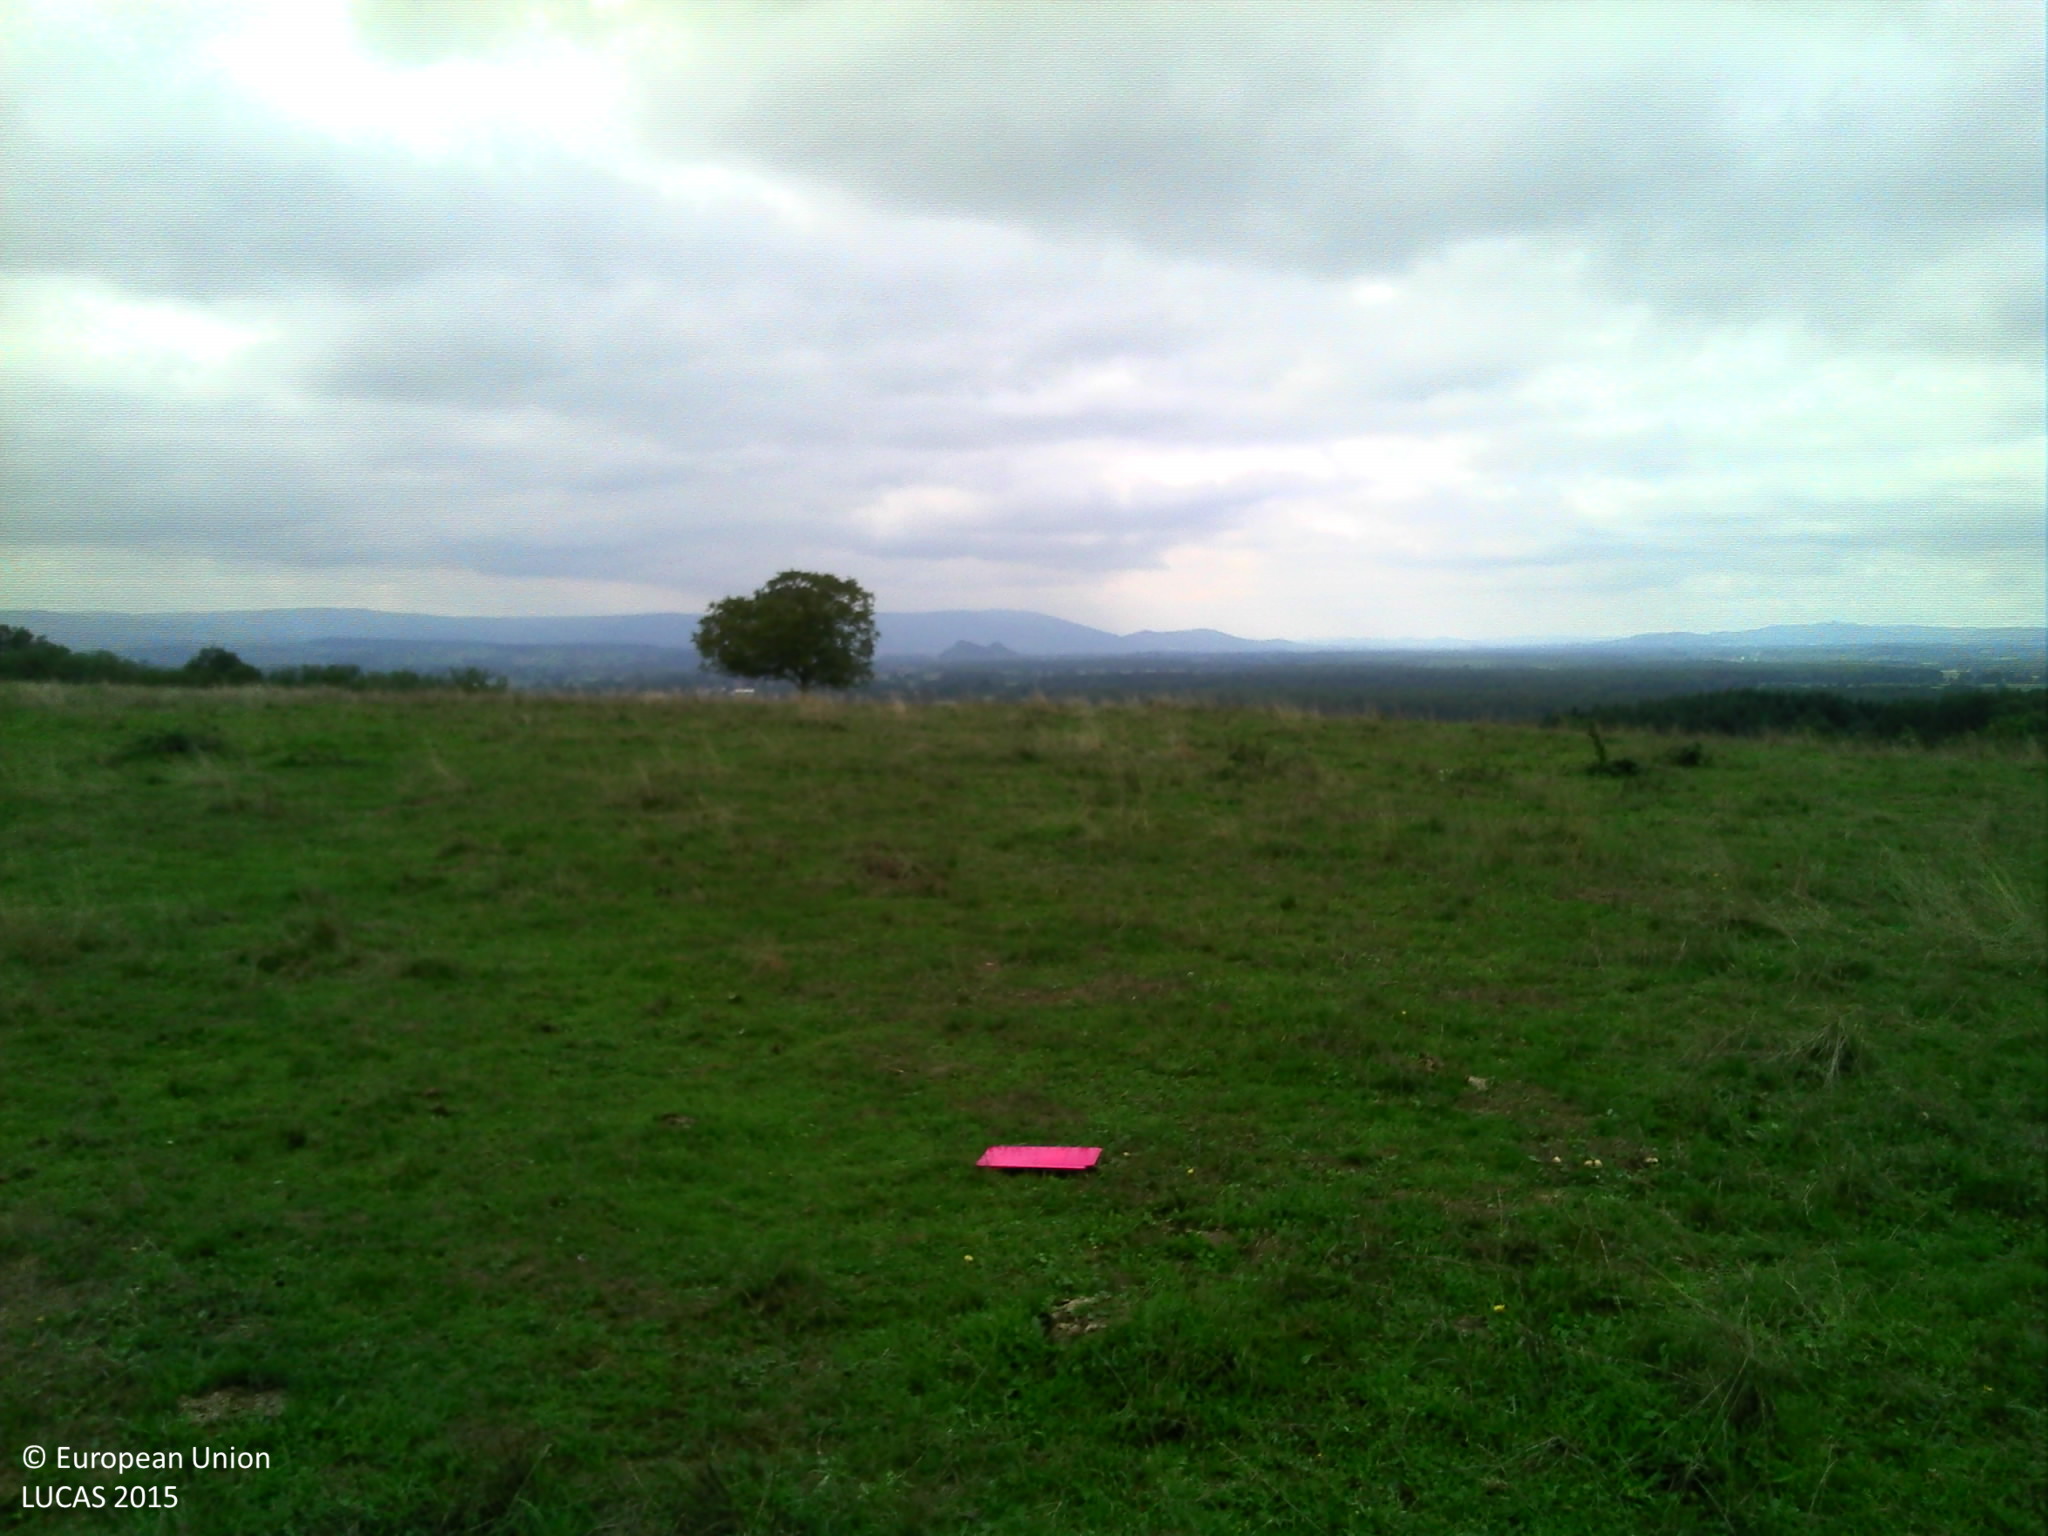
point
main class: Grassland
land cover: Grassland without tree/shrub cover
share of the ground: > 75 %
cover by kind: herbaceous plants 100 %
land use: Agriculture (excluding fallow land and kitchen gardens)
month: September
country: FR
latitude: 47.0683
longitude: 4.3507
